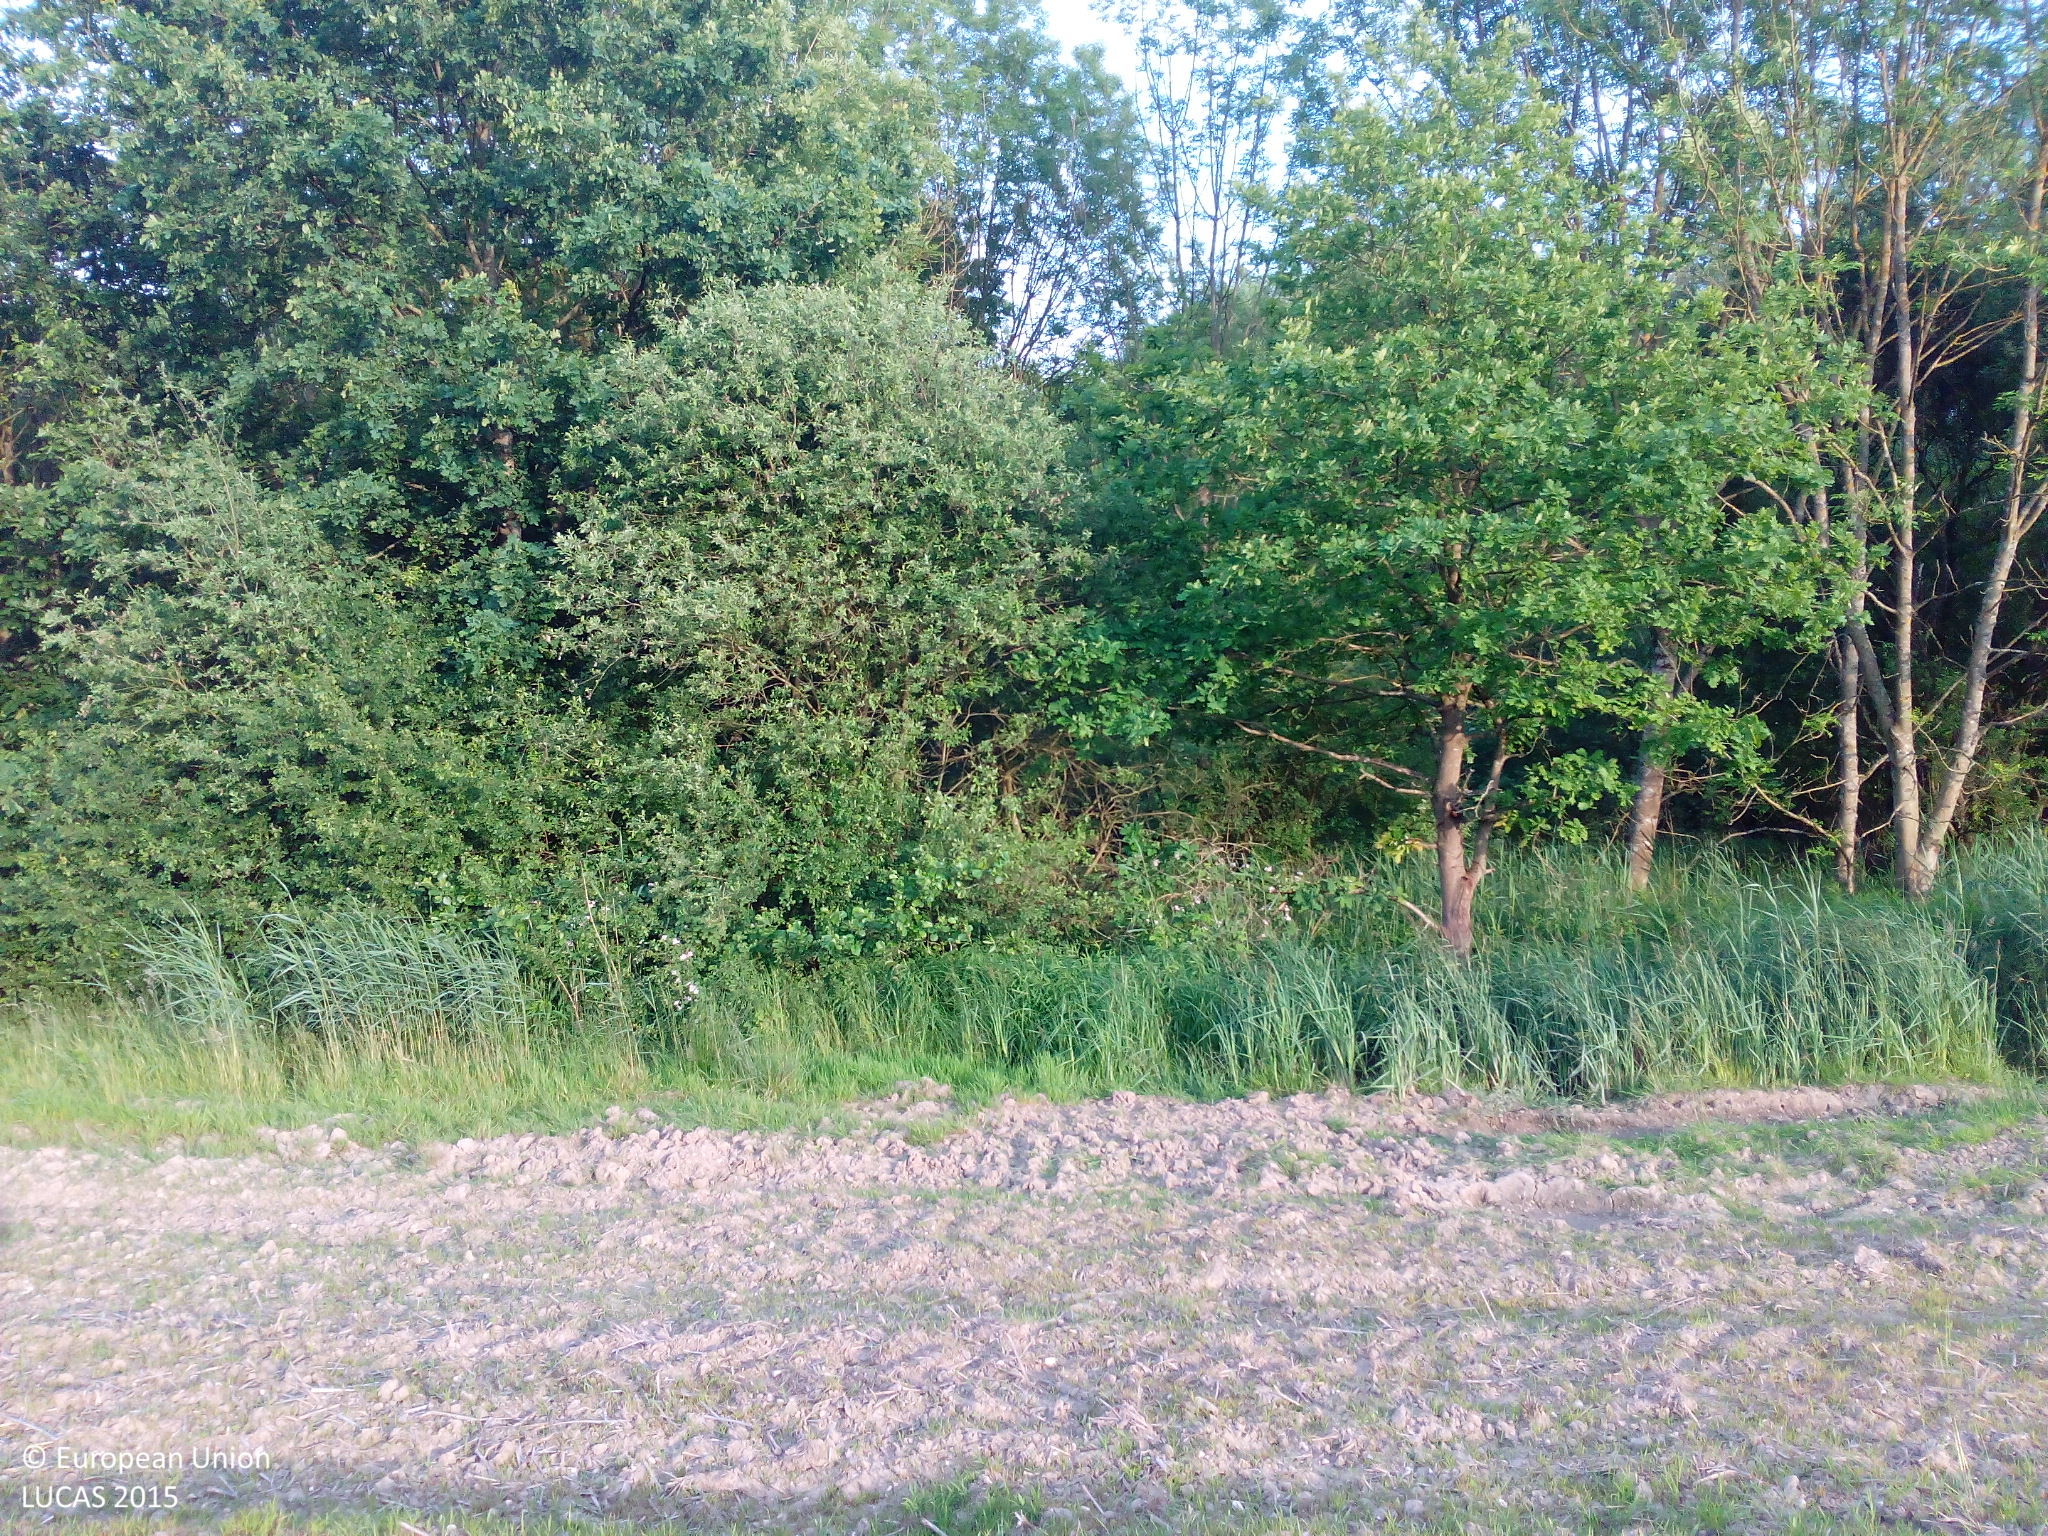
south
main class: Cropland
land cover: Temporary grasslands
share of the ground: 25 - 50 %
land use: Agriculture (excluding fallow land and kitchen gardens)
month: May
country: DE
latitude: 49.0184
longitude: 8.1820
